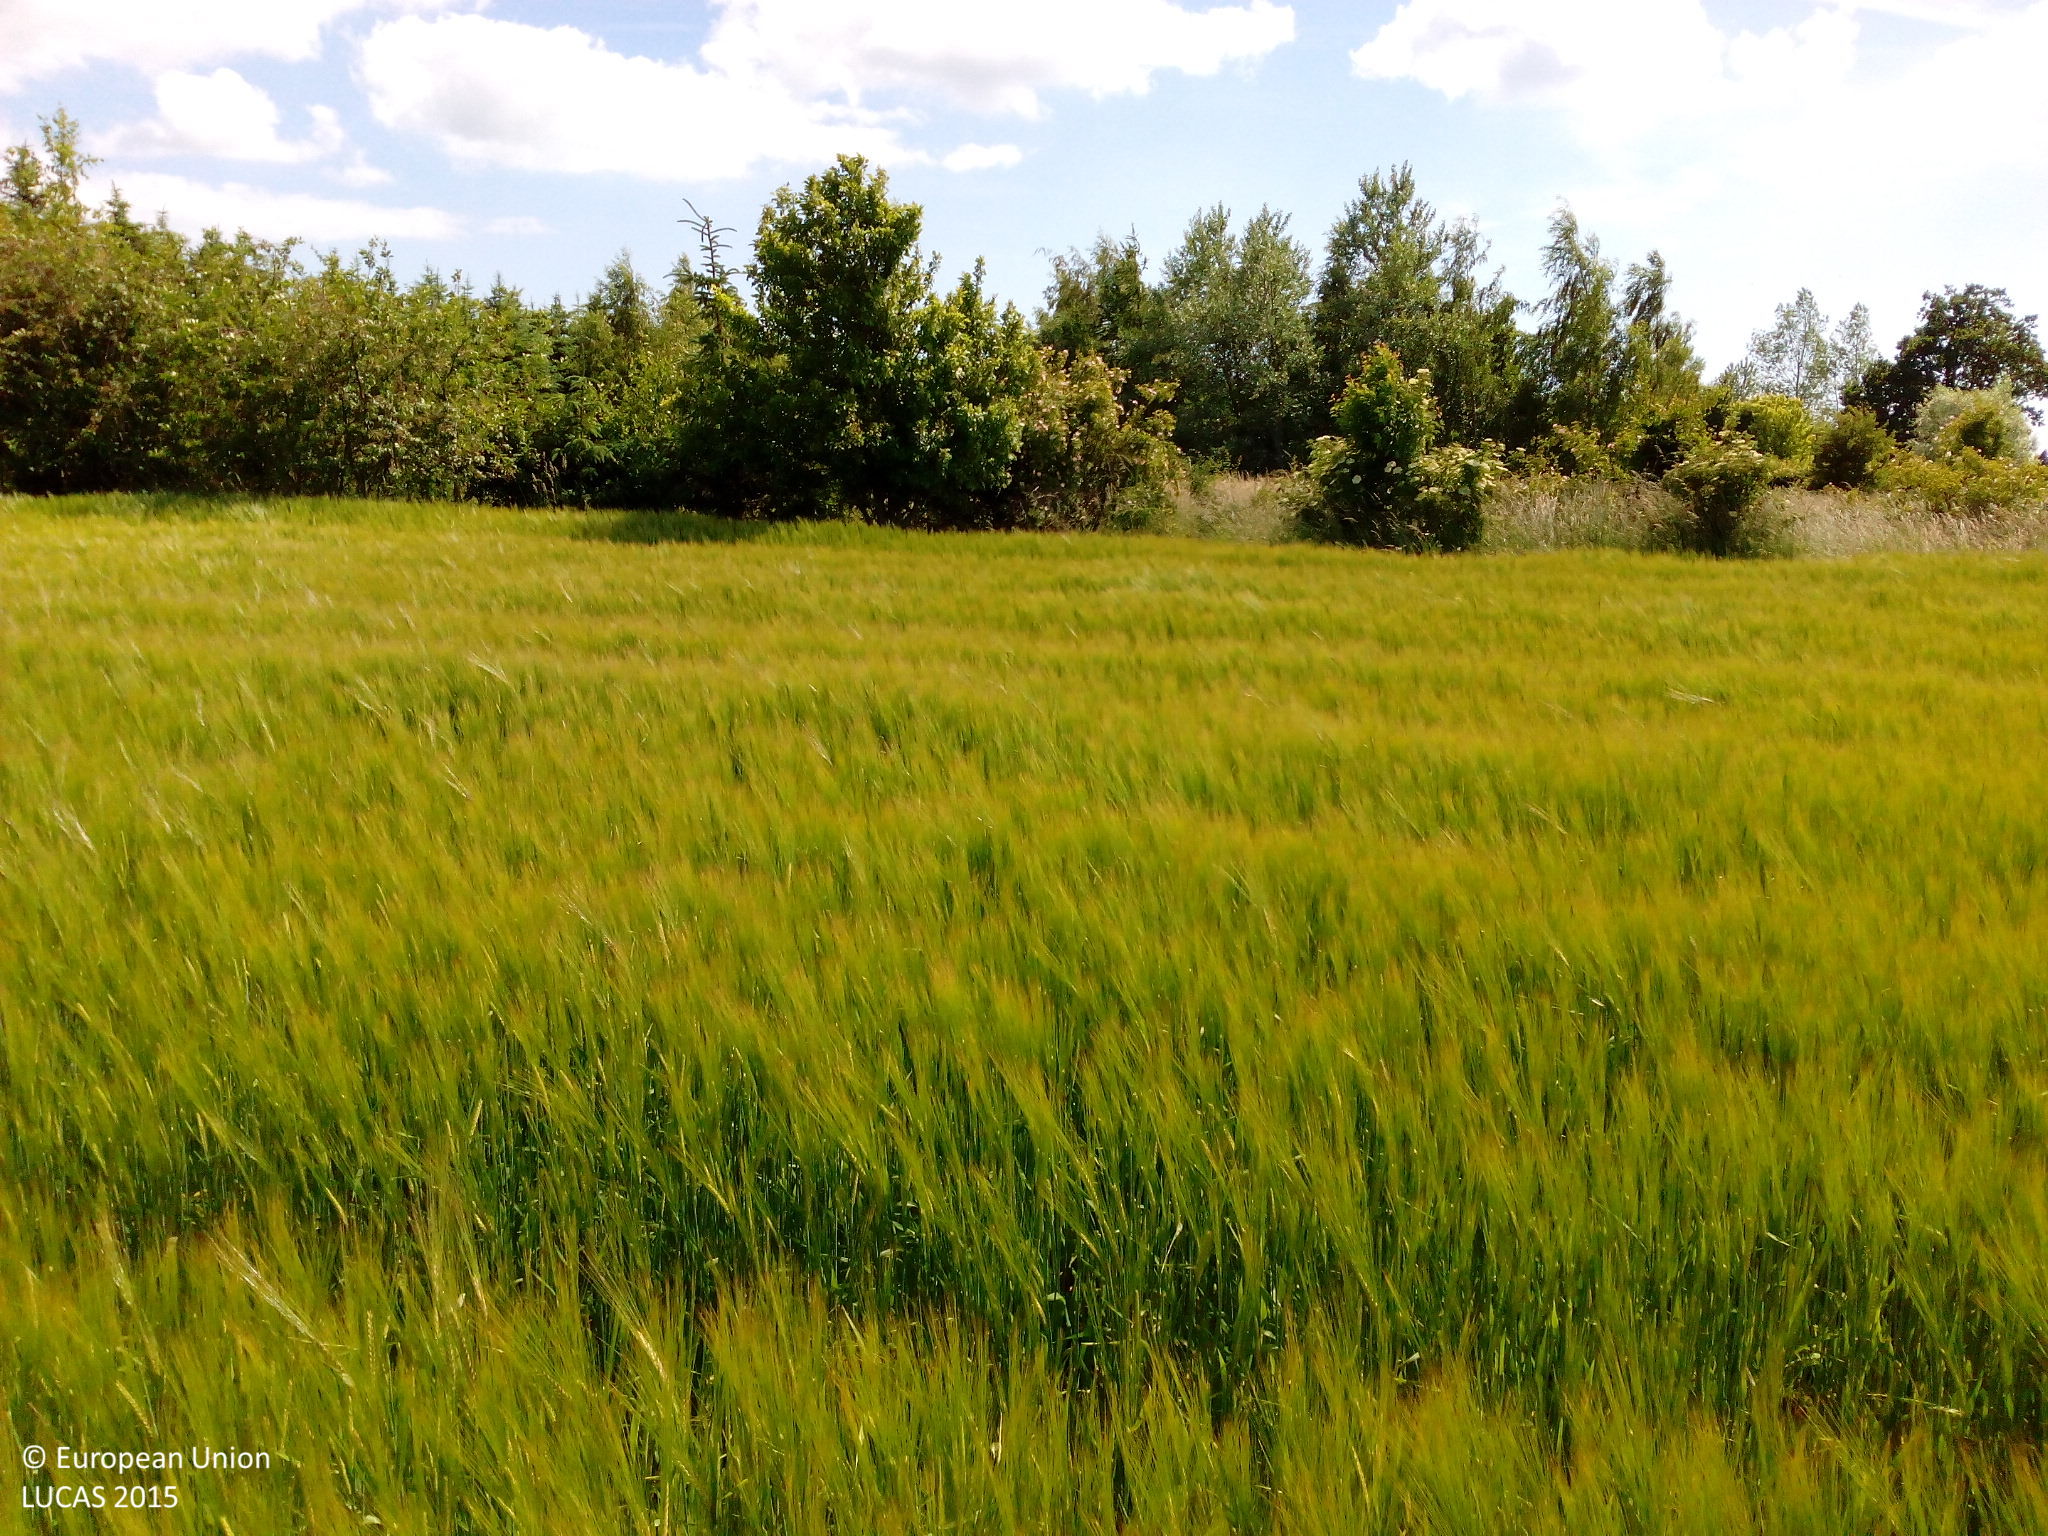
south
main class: Cropland
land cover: Barley
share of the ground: > 75 %
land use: Agriculture (excluding fallow land and kitchen gardens)
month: June
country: DK
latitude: 54.6638
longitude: 11.8748
